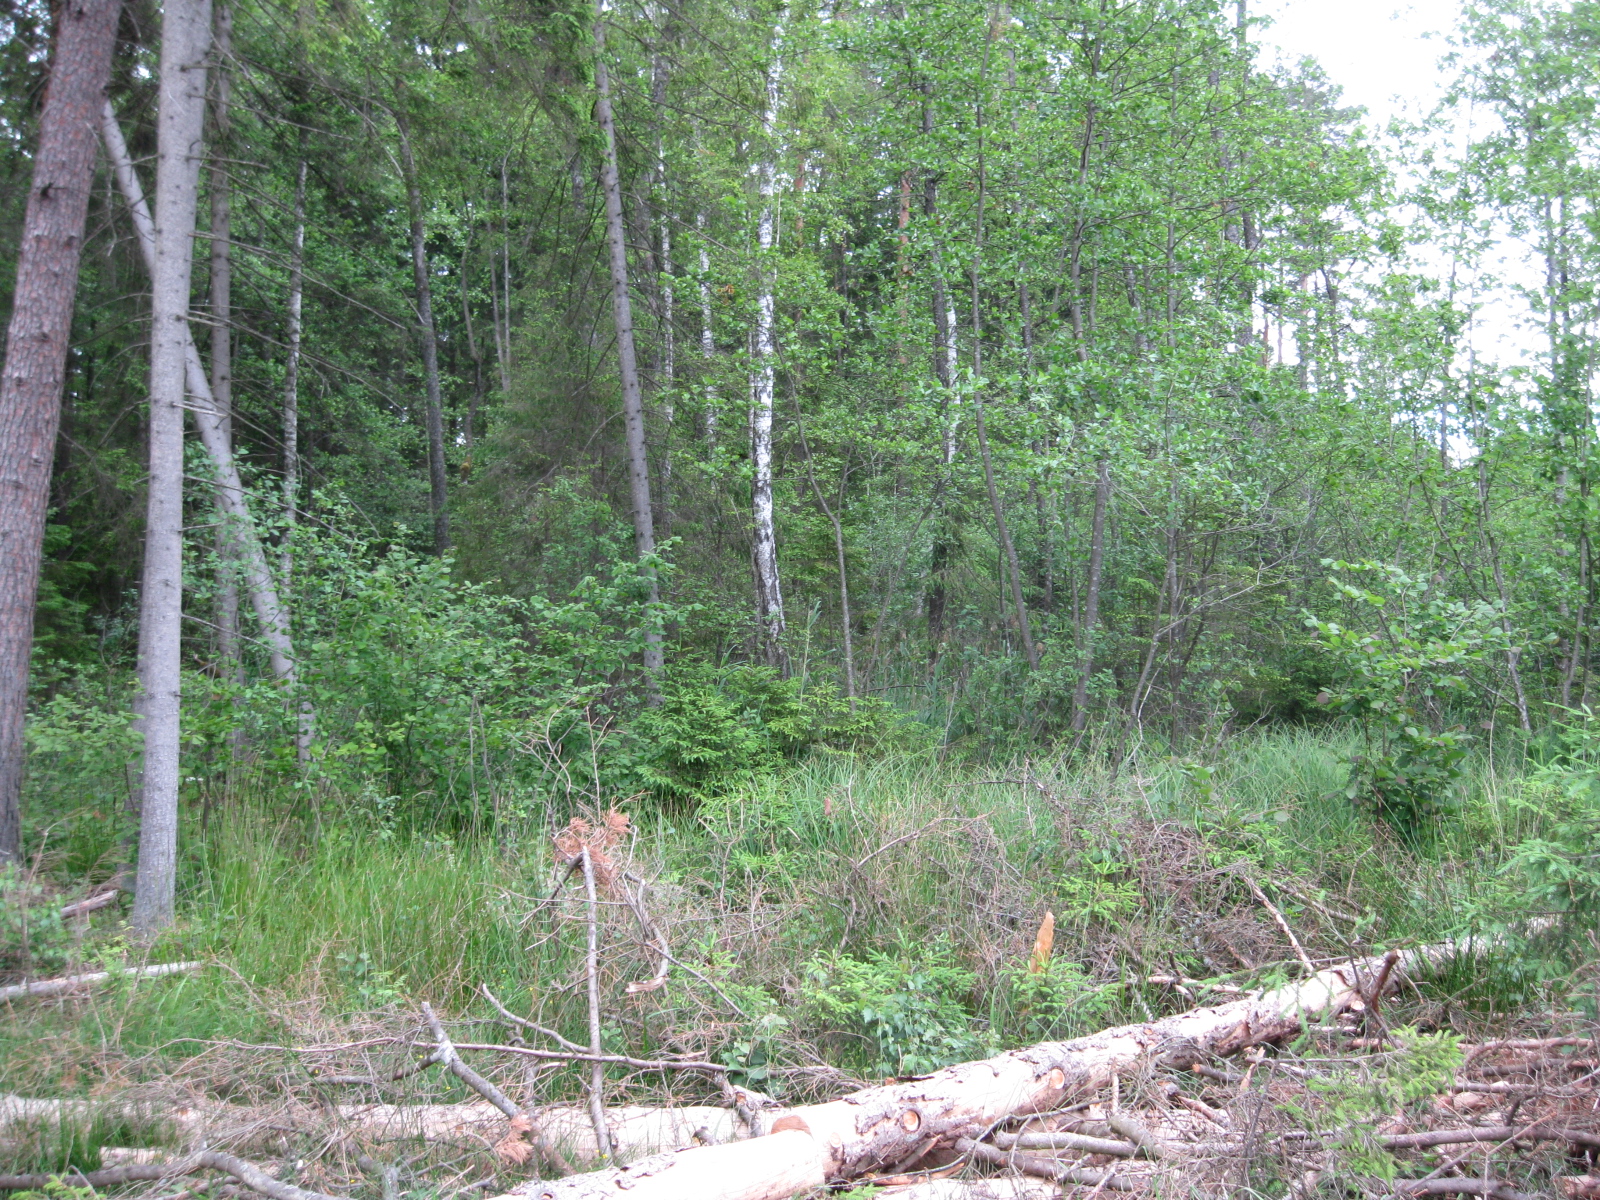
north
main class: Woodland
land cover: Other coniferous woodland
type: hemiboreal forest and nemoral coniferous forest and mixed broadleaved-coniferous forest
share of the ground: 50 - 75 %
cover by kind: coniferous forest trees 50 %, herbaceous plants 20 %, broadleaved forest trees 10 %, shrubs 10 %, unconsolidated bare surface 10 %
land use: Forestry
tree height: > 5 m
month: June
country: LT
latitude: 55.5409
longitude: 24.1810
